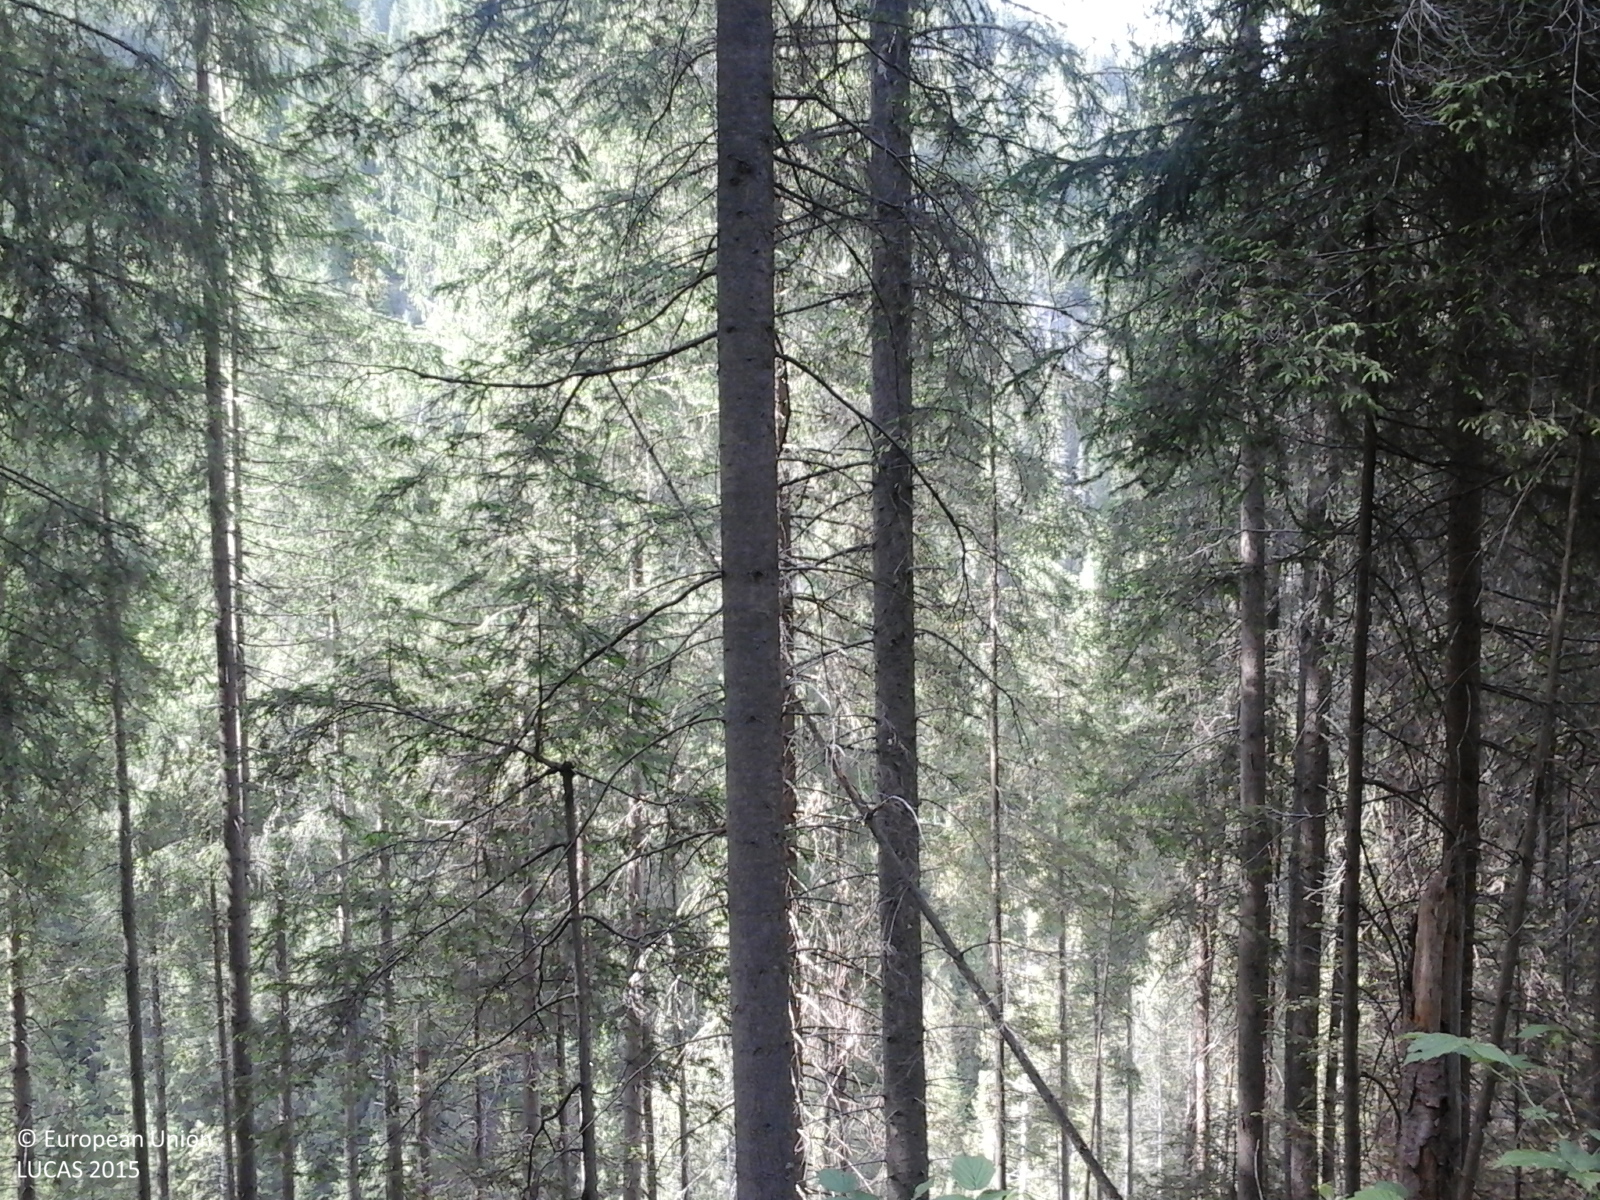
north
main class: Woodland
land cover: Spruce dominated coniferous woodland
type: alpine coniferous forest
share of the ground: > 75 %
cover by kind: coniferous forest trees 100 %
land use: Forestry
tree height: > 5 m
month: June
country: RO
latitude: 47.1895
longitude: 25.5161
